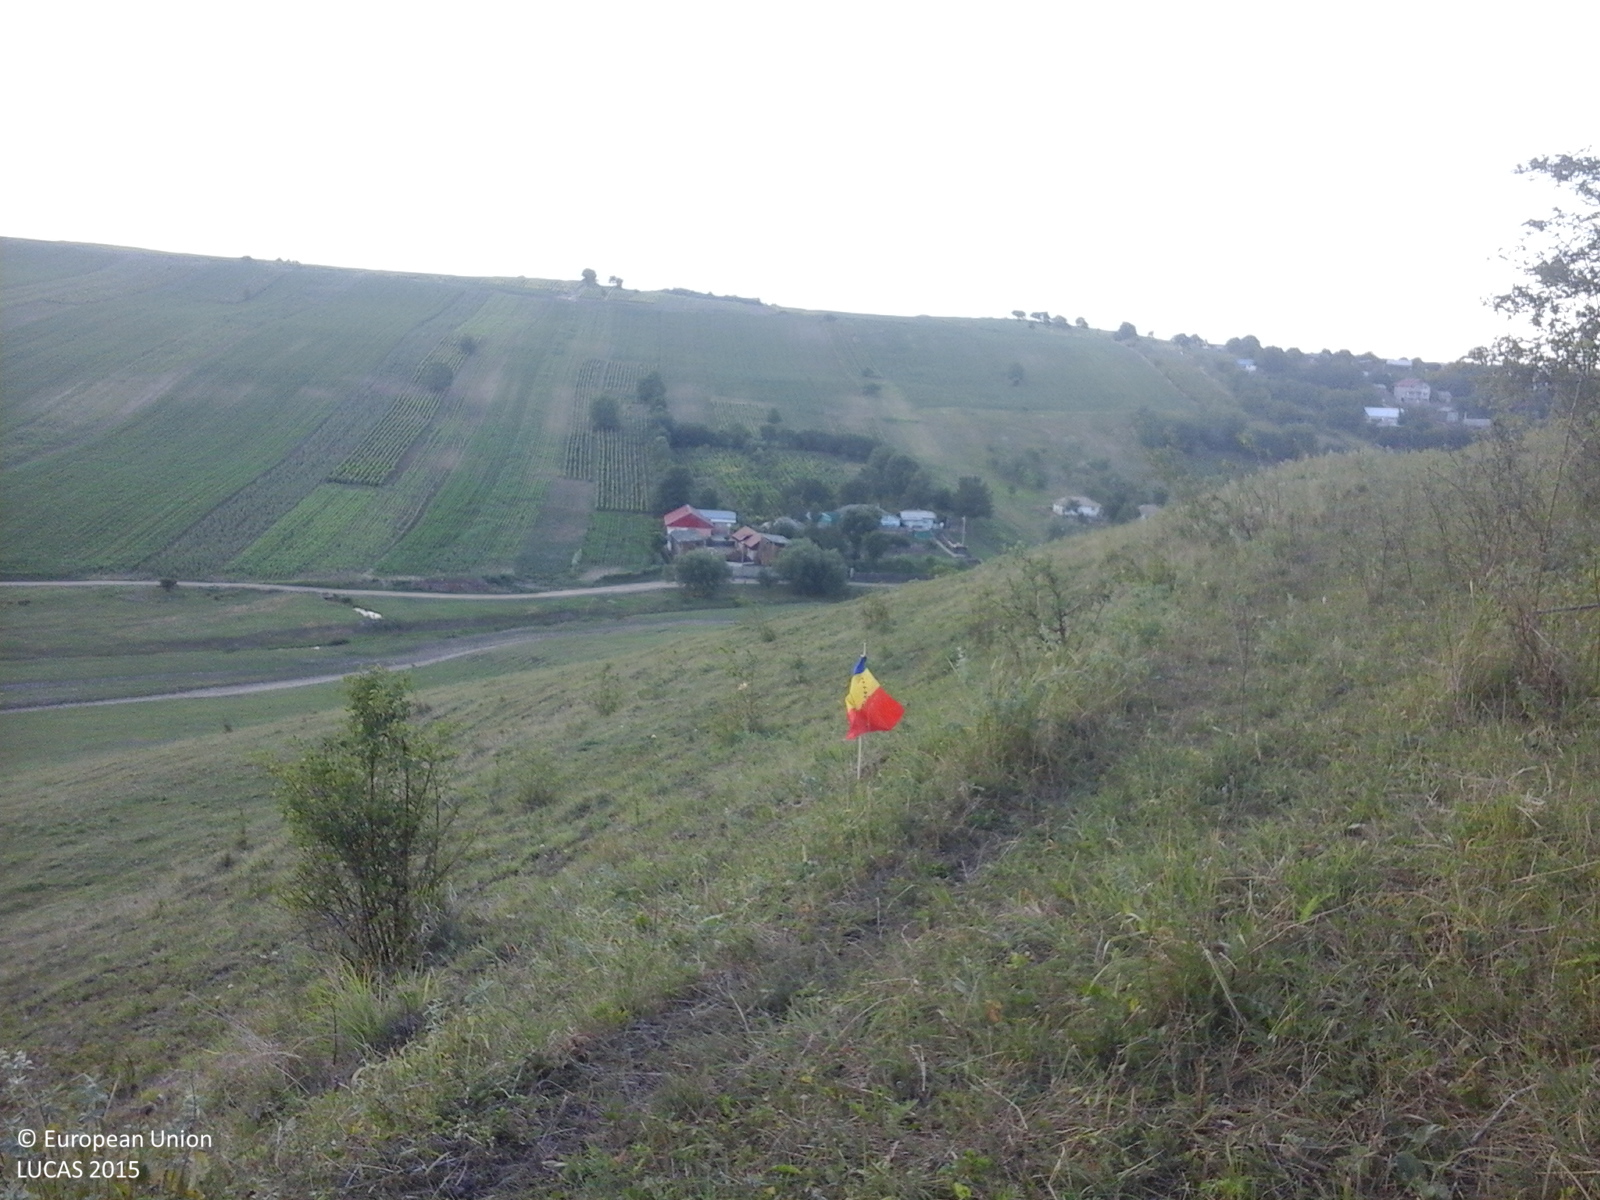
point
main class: Grassland
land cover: Grassland with sparse tree/shrub cover
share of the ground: > 75 %
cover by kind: herbaceous plants 85 %, shrubs 10 %, broadleaved forest trees 5 %
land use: Agriculture (excluding fallow land and kitchen gardens)
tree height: < 5 m
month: June
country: RO
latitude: 47.1834
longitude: 27.0055
